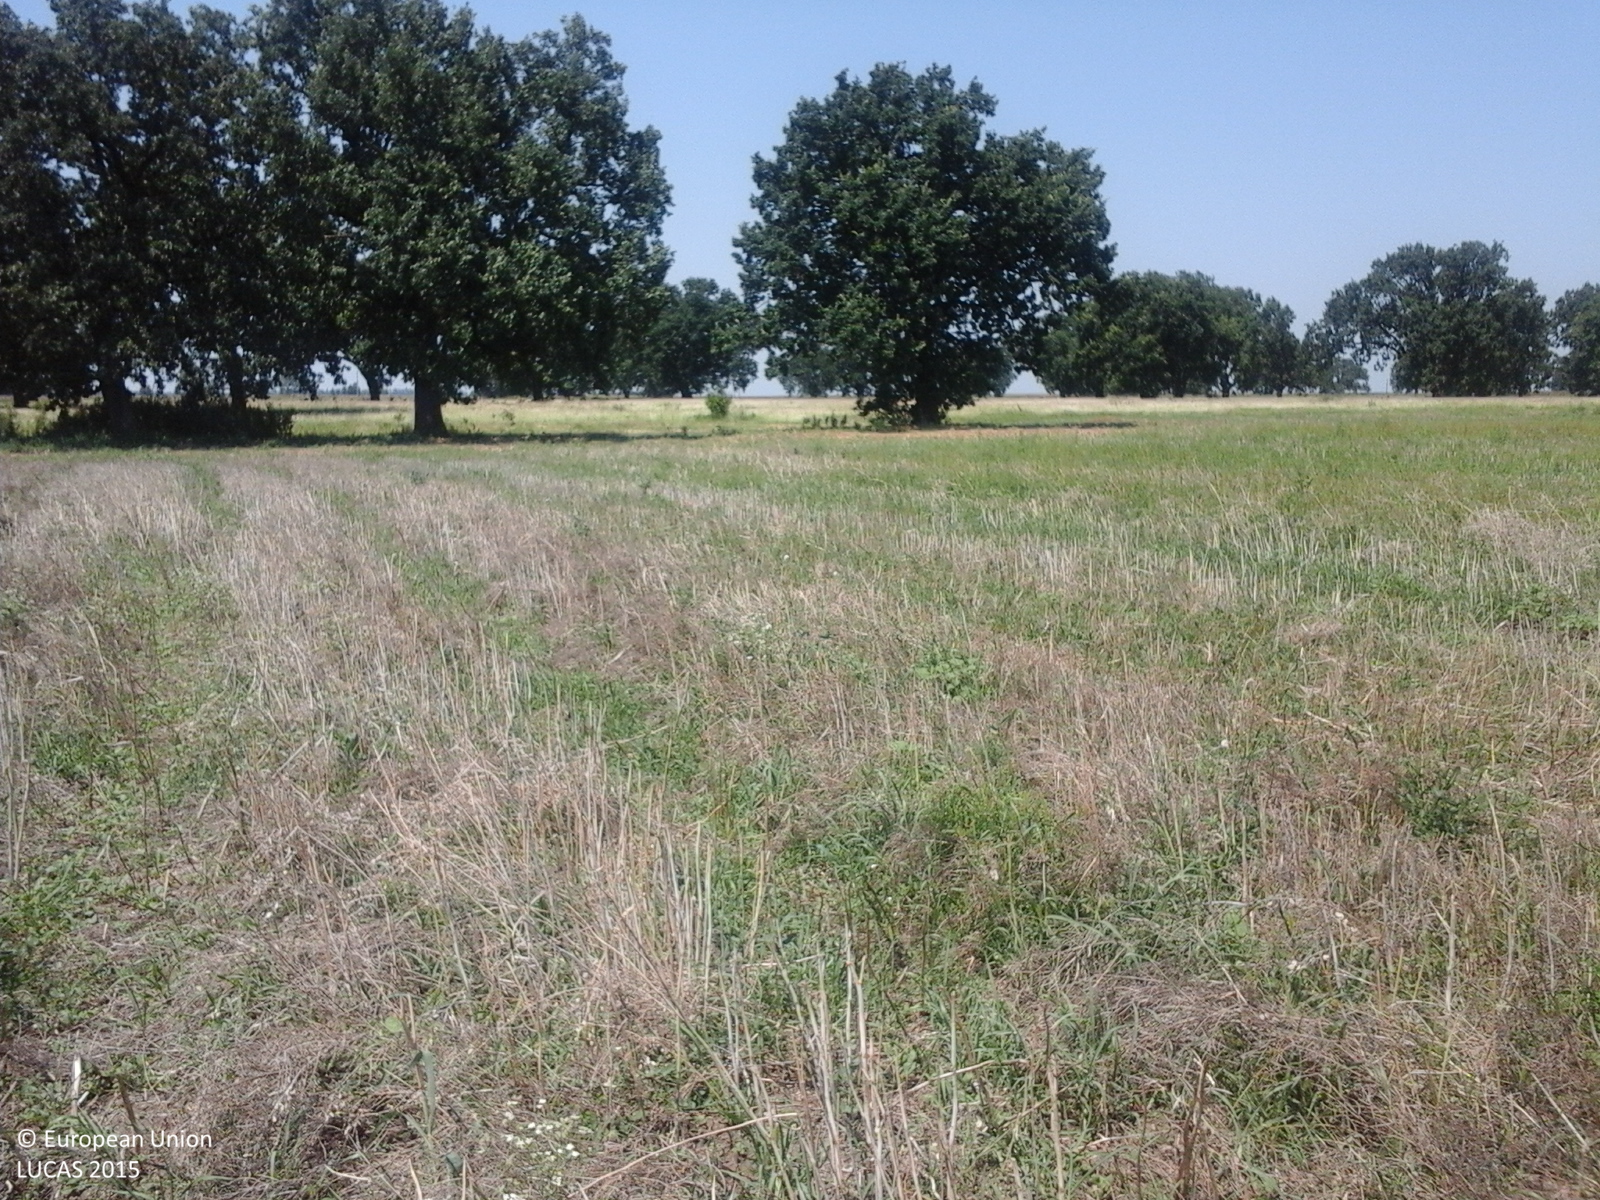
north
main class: Cropland
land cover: Rape and turnip rape
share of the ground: > 75 %
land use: Agriculture (excluding fallow land and kitchen gardens)
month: July
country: RO
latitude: 44.7063
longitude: 26.7468
